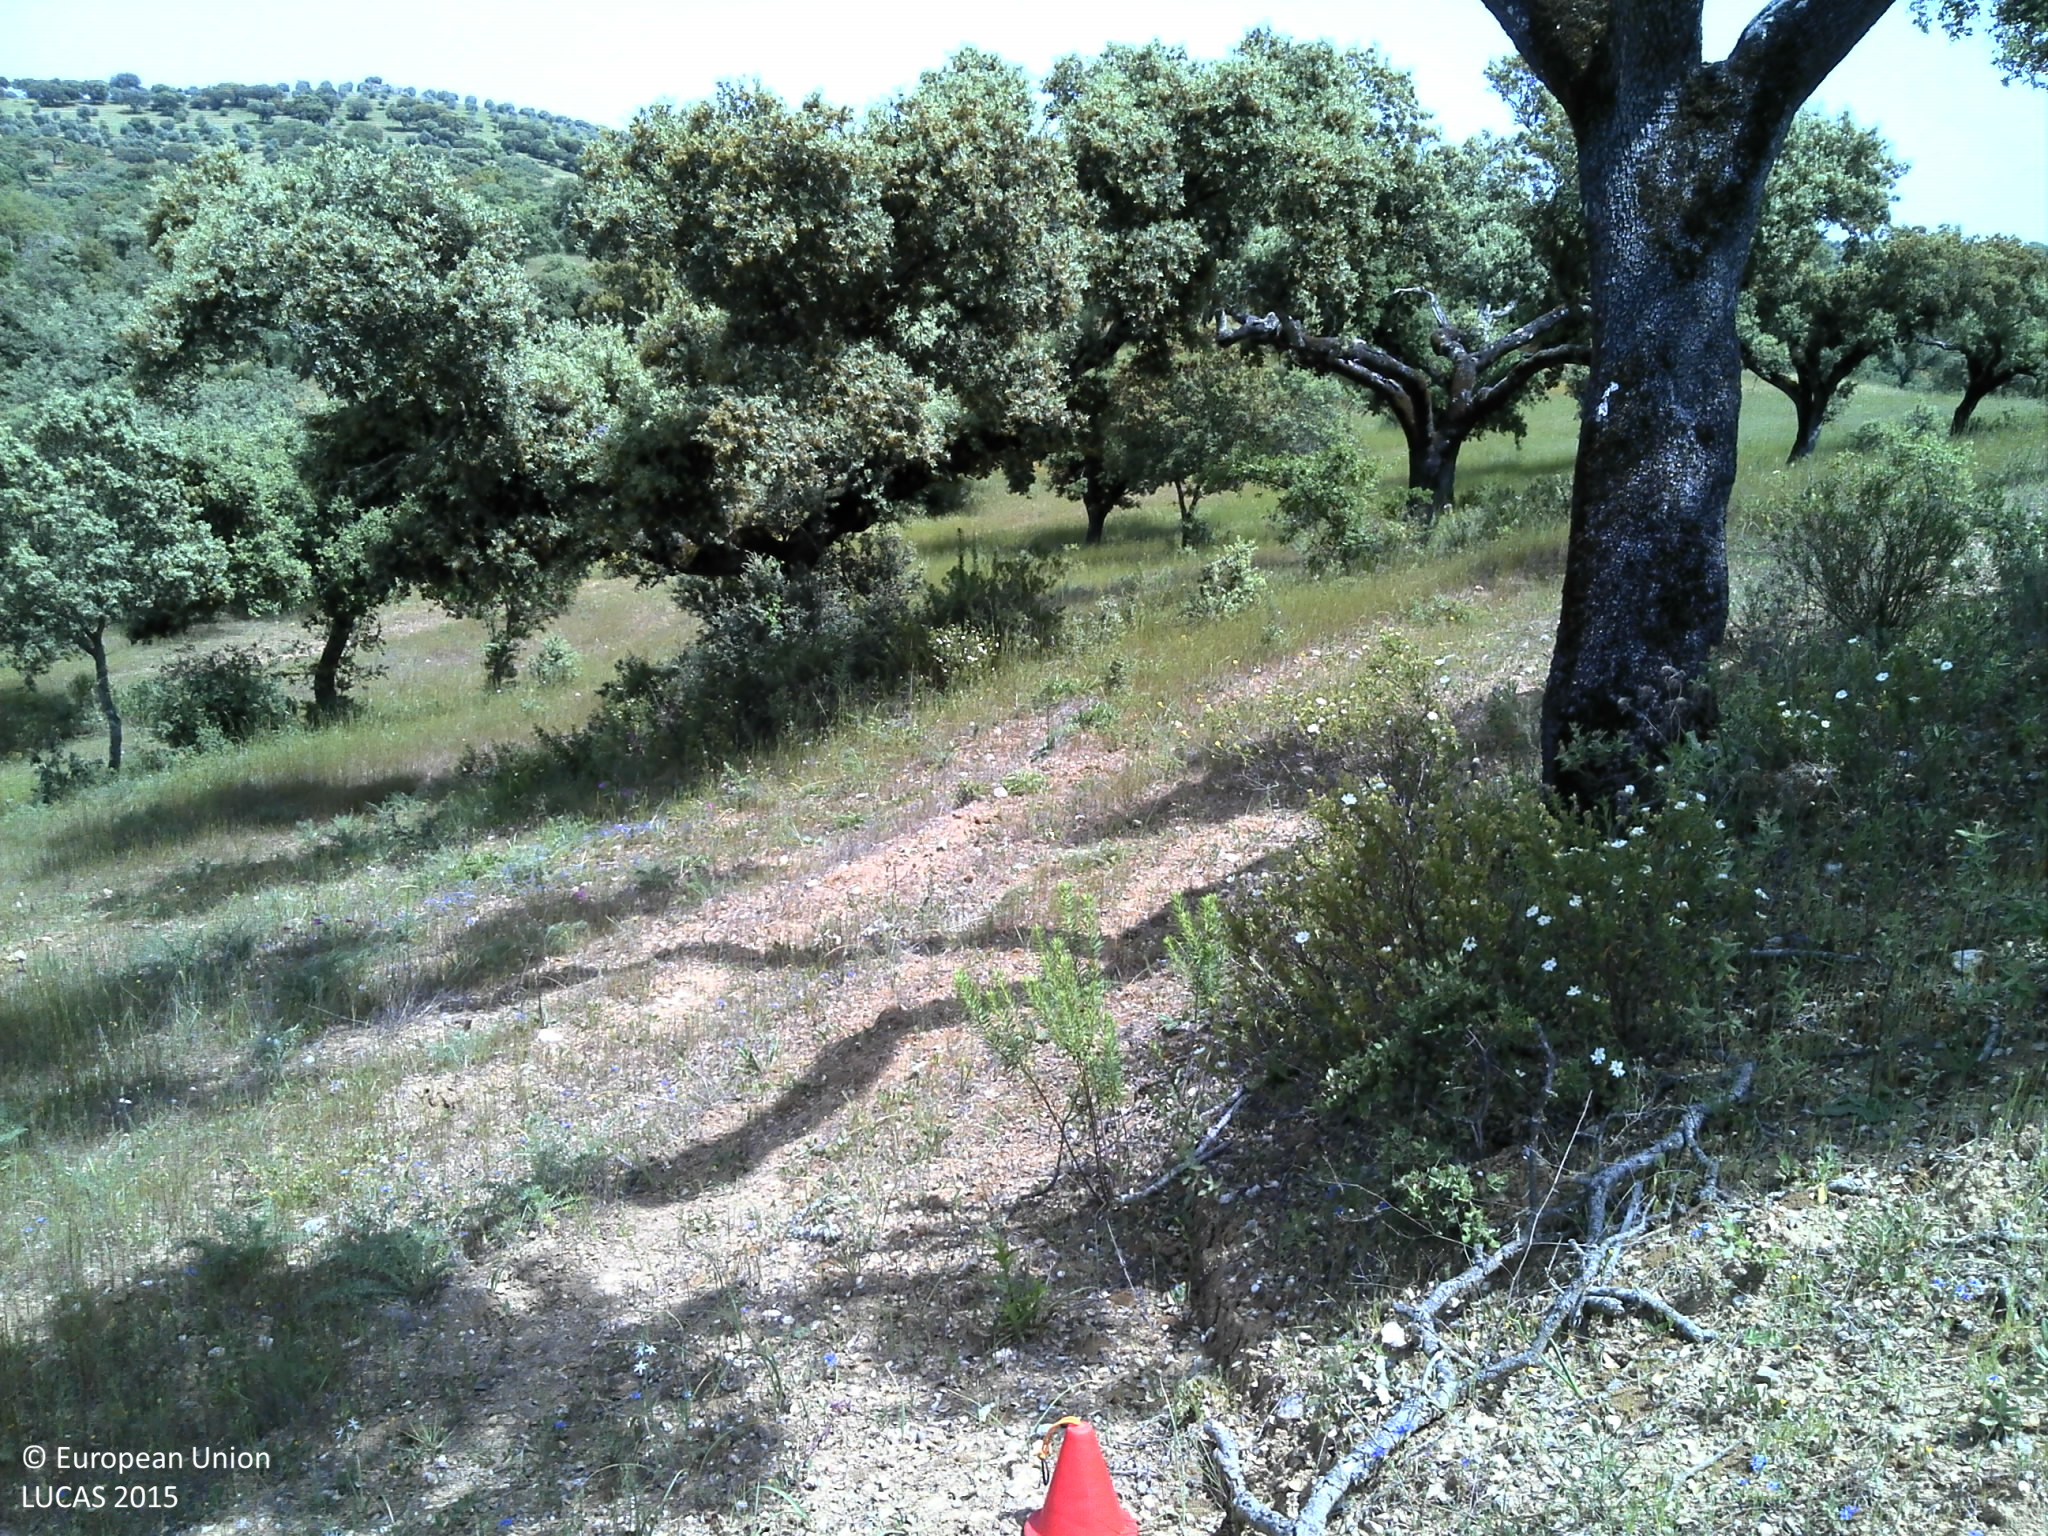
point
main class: Woodland
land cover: Broadleaved woodland
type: broadleaved evergreen forest
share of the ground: 50 - 75 %
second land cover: Grassland without tree/shrub cover
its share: 10 - 25 %
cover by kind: broadleaved forest trees 60 %, herbaceous plants 25 %, unconsolidated bare surface 15 %
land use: Forestry
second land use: Agriculture (excluding fallow land and kitchen gardens)
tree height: > 5 m
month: May
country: PT
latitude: 39.0142
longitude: -7.8907
